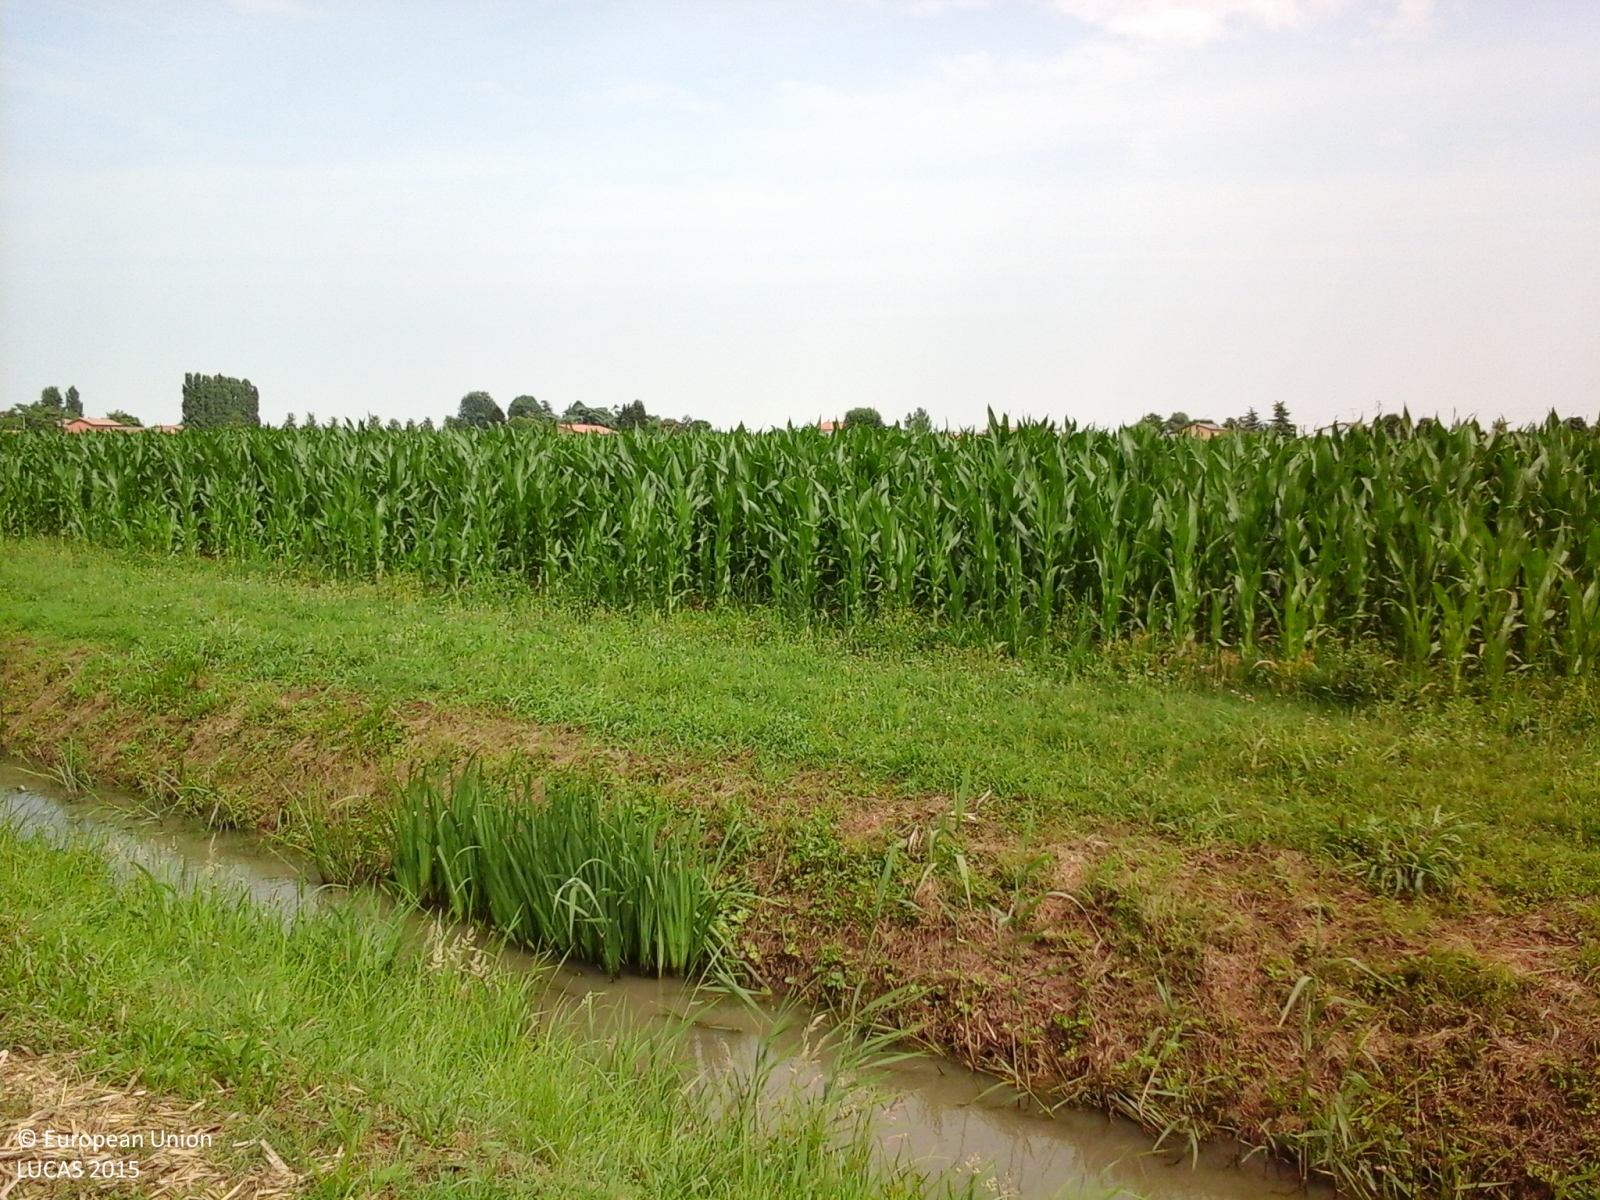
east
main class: Cropland
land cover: Common wheat
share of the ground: > 75 %
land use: Agriculture (excluding fallow land and kitchen gardens)
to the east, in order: Common wheat; Tracks; Grass margins; Ditches and canals; Grass margins; Tracks; Maize; Tracks; Ditches and canals; Grass margins; Sugar beet; Ditches and canals; Sugar beet
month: June
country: IT
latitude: 44.5908
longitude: 11.5964
